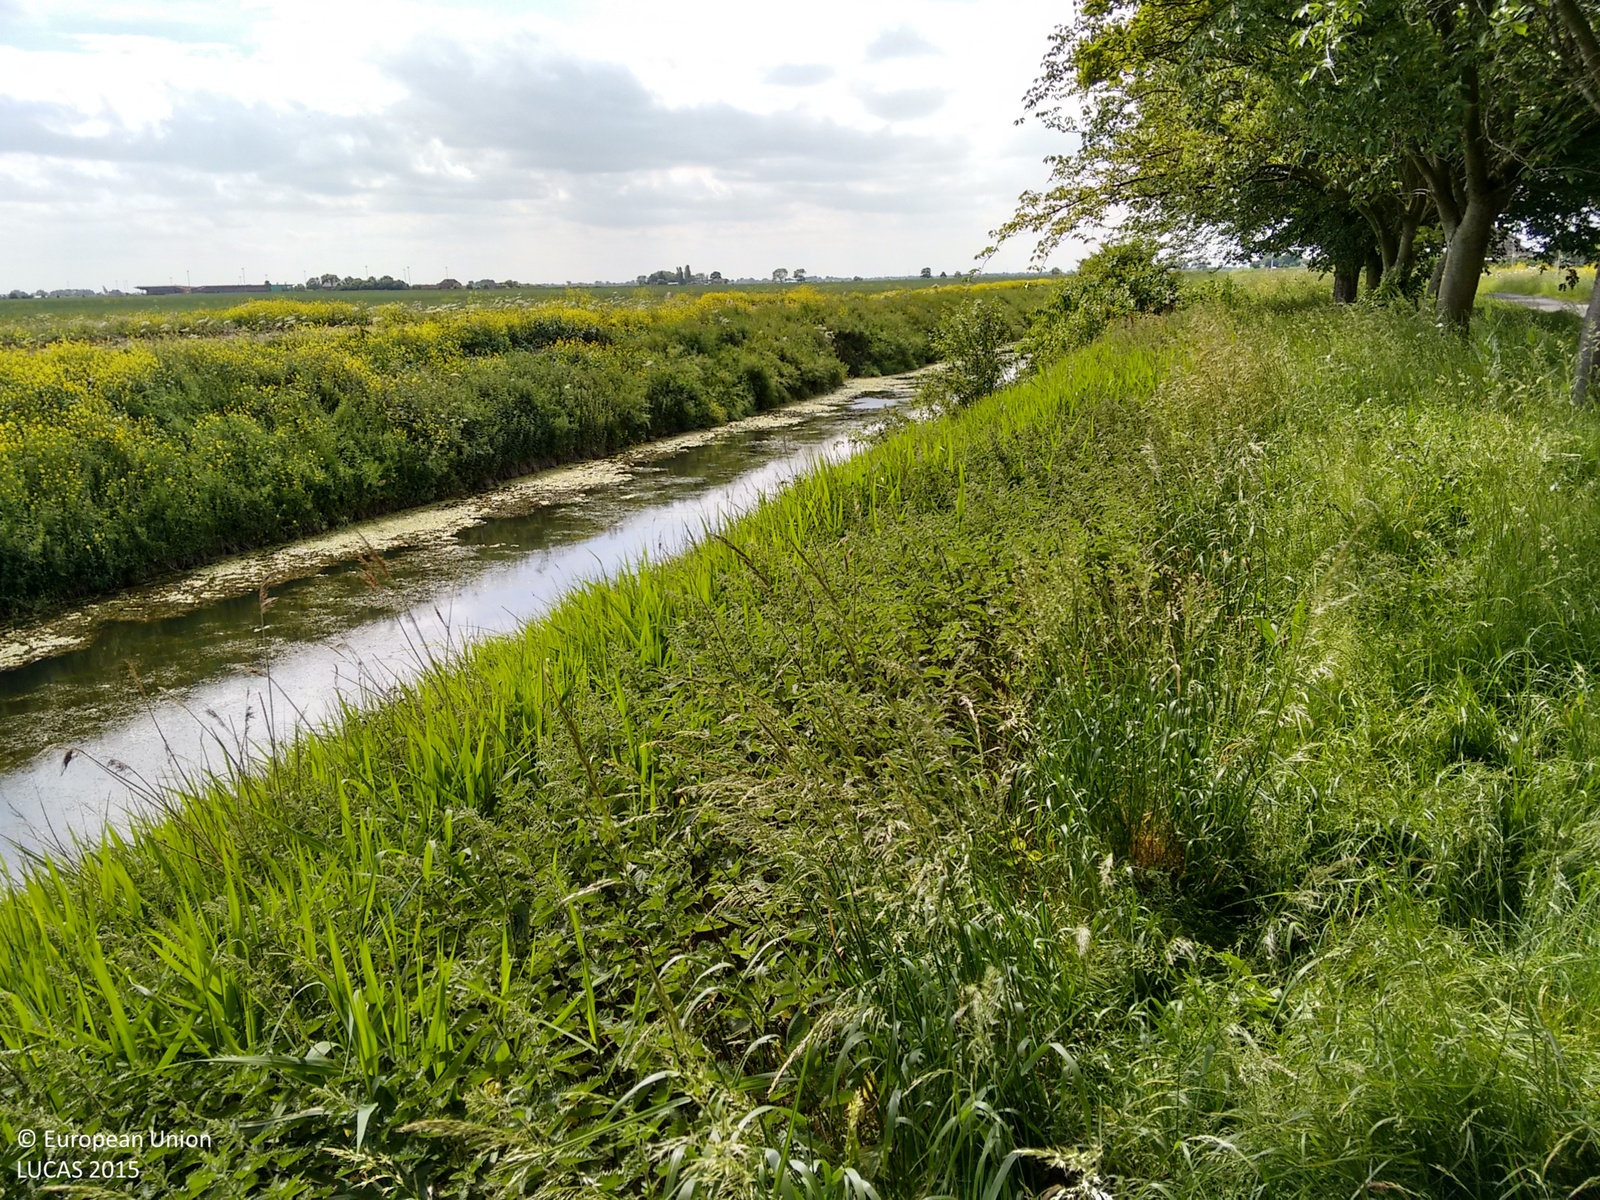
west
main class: Cropland
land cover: Maize
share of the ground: 25 - 50 %
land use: Agriculture (excluding fallow land and kitchen gardens)
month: June
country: GB
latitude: 52.9823
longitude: -0.0568
